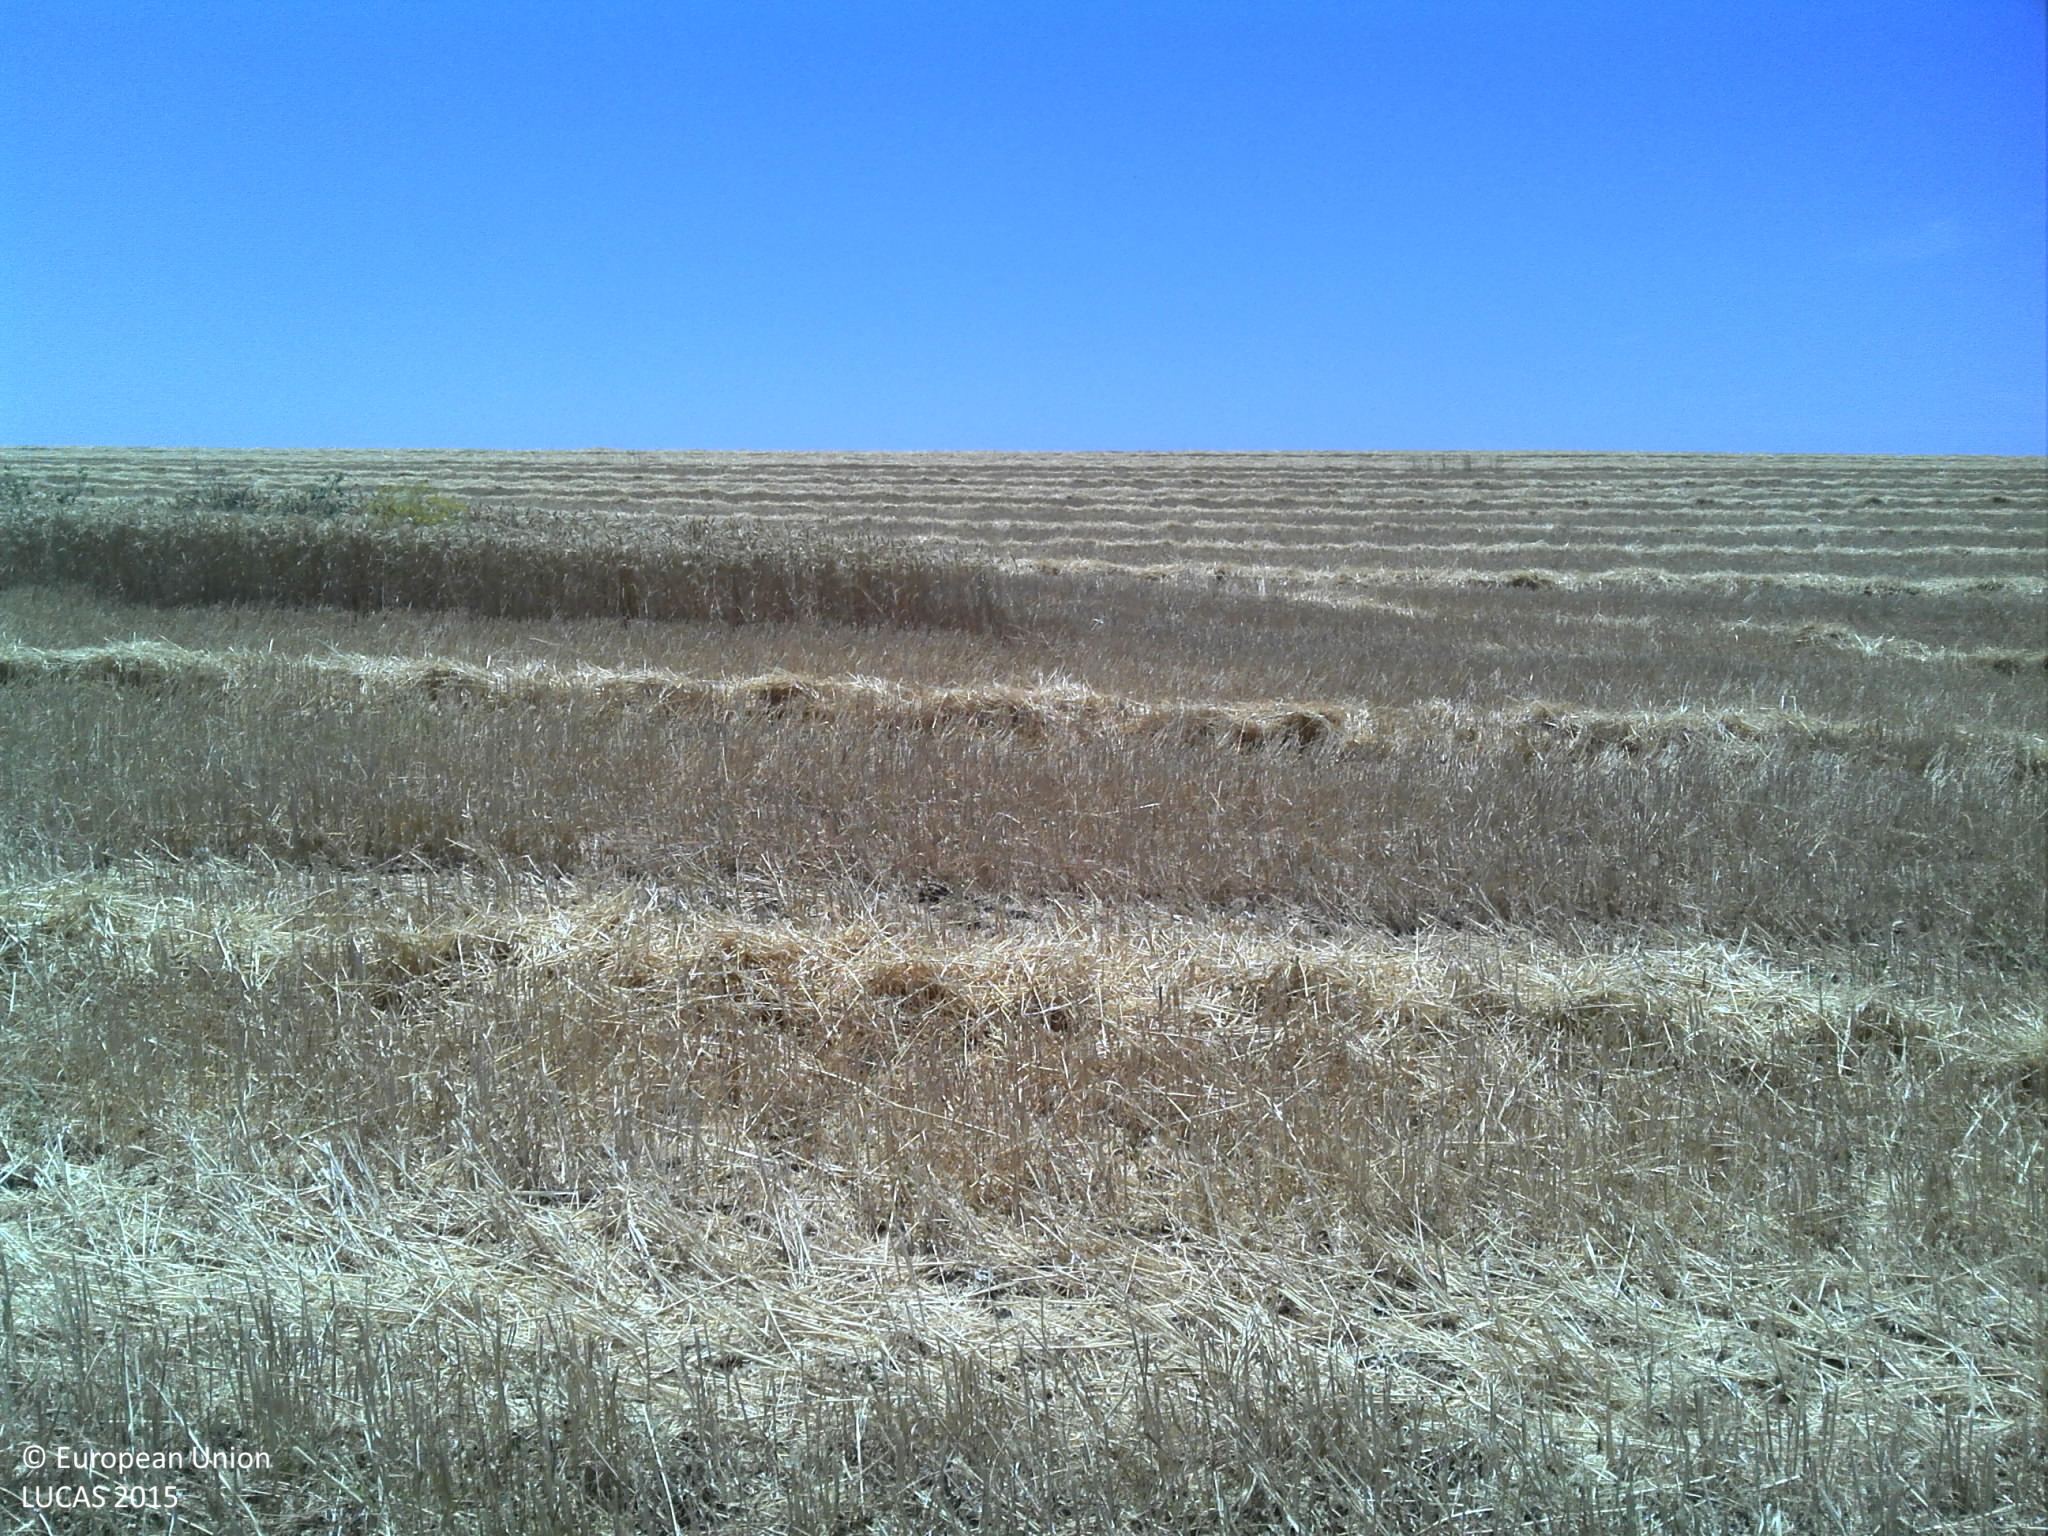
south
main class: Cropland
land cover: Common wheat
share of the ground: > 75 %
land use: Agriculture (excluding fallow land and kitchen gardens)
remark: Harvested field
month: June
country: PT
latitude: 37.9362
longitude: -7.5294
